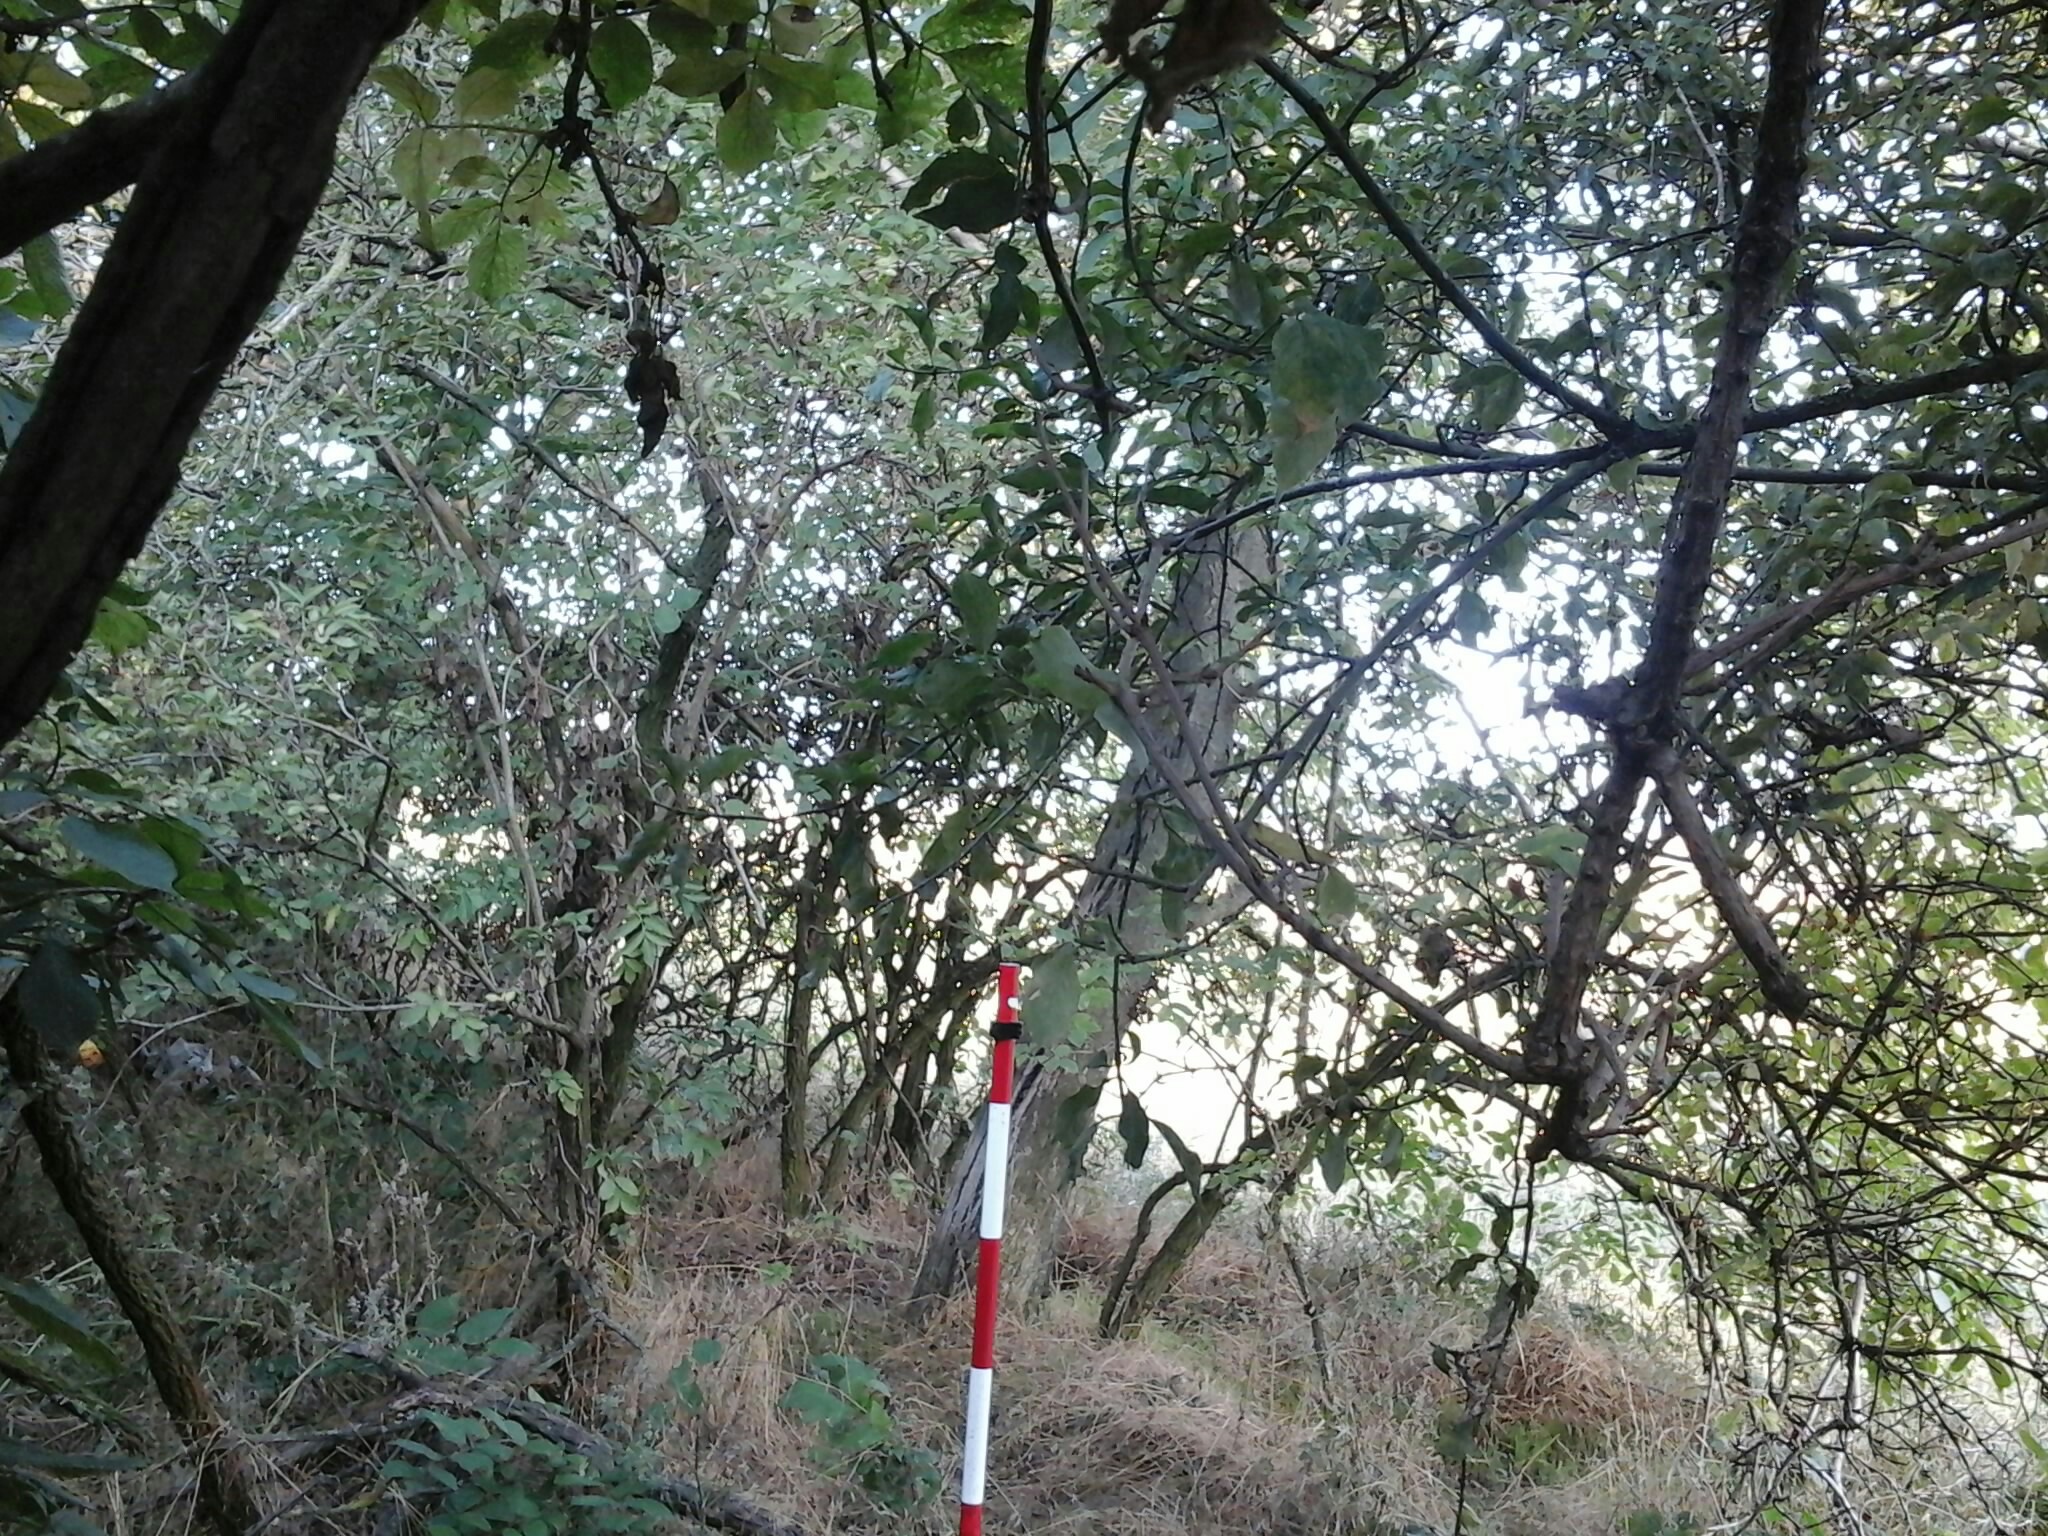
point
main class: Woodland
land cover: Broadleaved woodland
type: mesophytic deciduous forest
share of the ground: > 75 %
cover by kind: broadleaved forest trees 80 %, shrubs 15 %, herbaceous plants 5 %
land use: Semi-natural and natural areas not in use
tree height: > 5 m
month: August
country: HU
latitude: 47.6583
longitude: 18.0405
